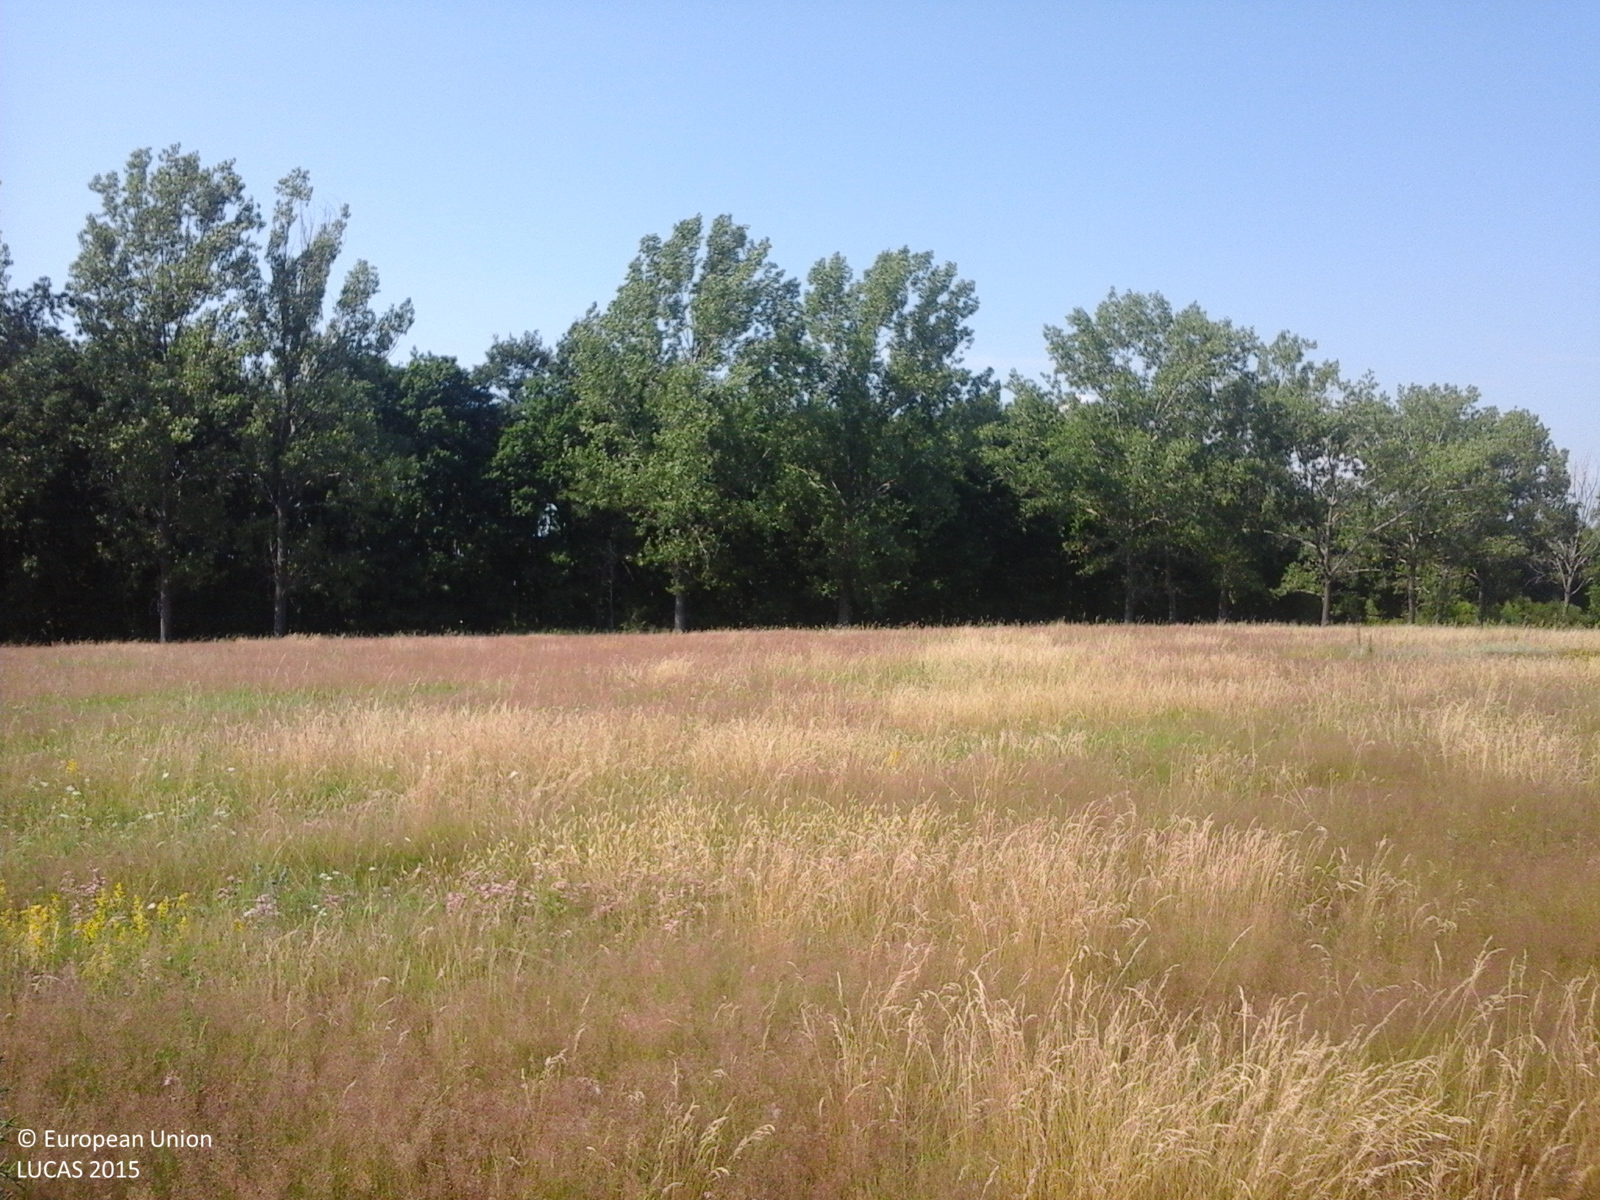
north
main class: Grassland
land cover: Grassland without tree/shrub cover
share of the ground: > 75 %
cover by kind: herbaceous plants 100 %
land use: Agriculture (excluding fallow land and kitchen gardens)
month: July
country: RO
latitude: 44.8539
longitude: 24.6931
